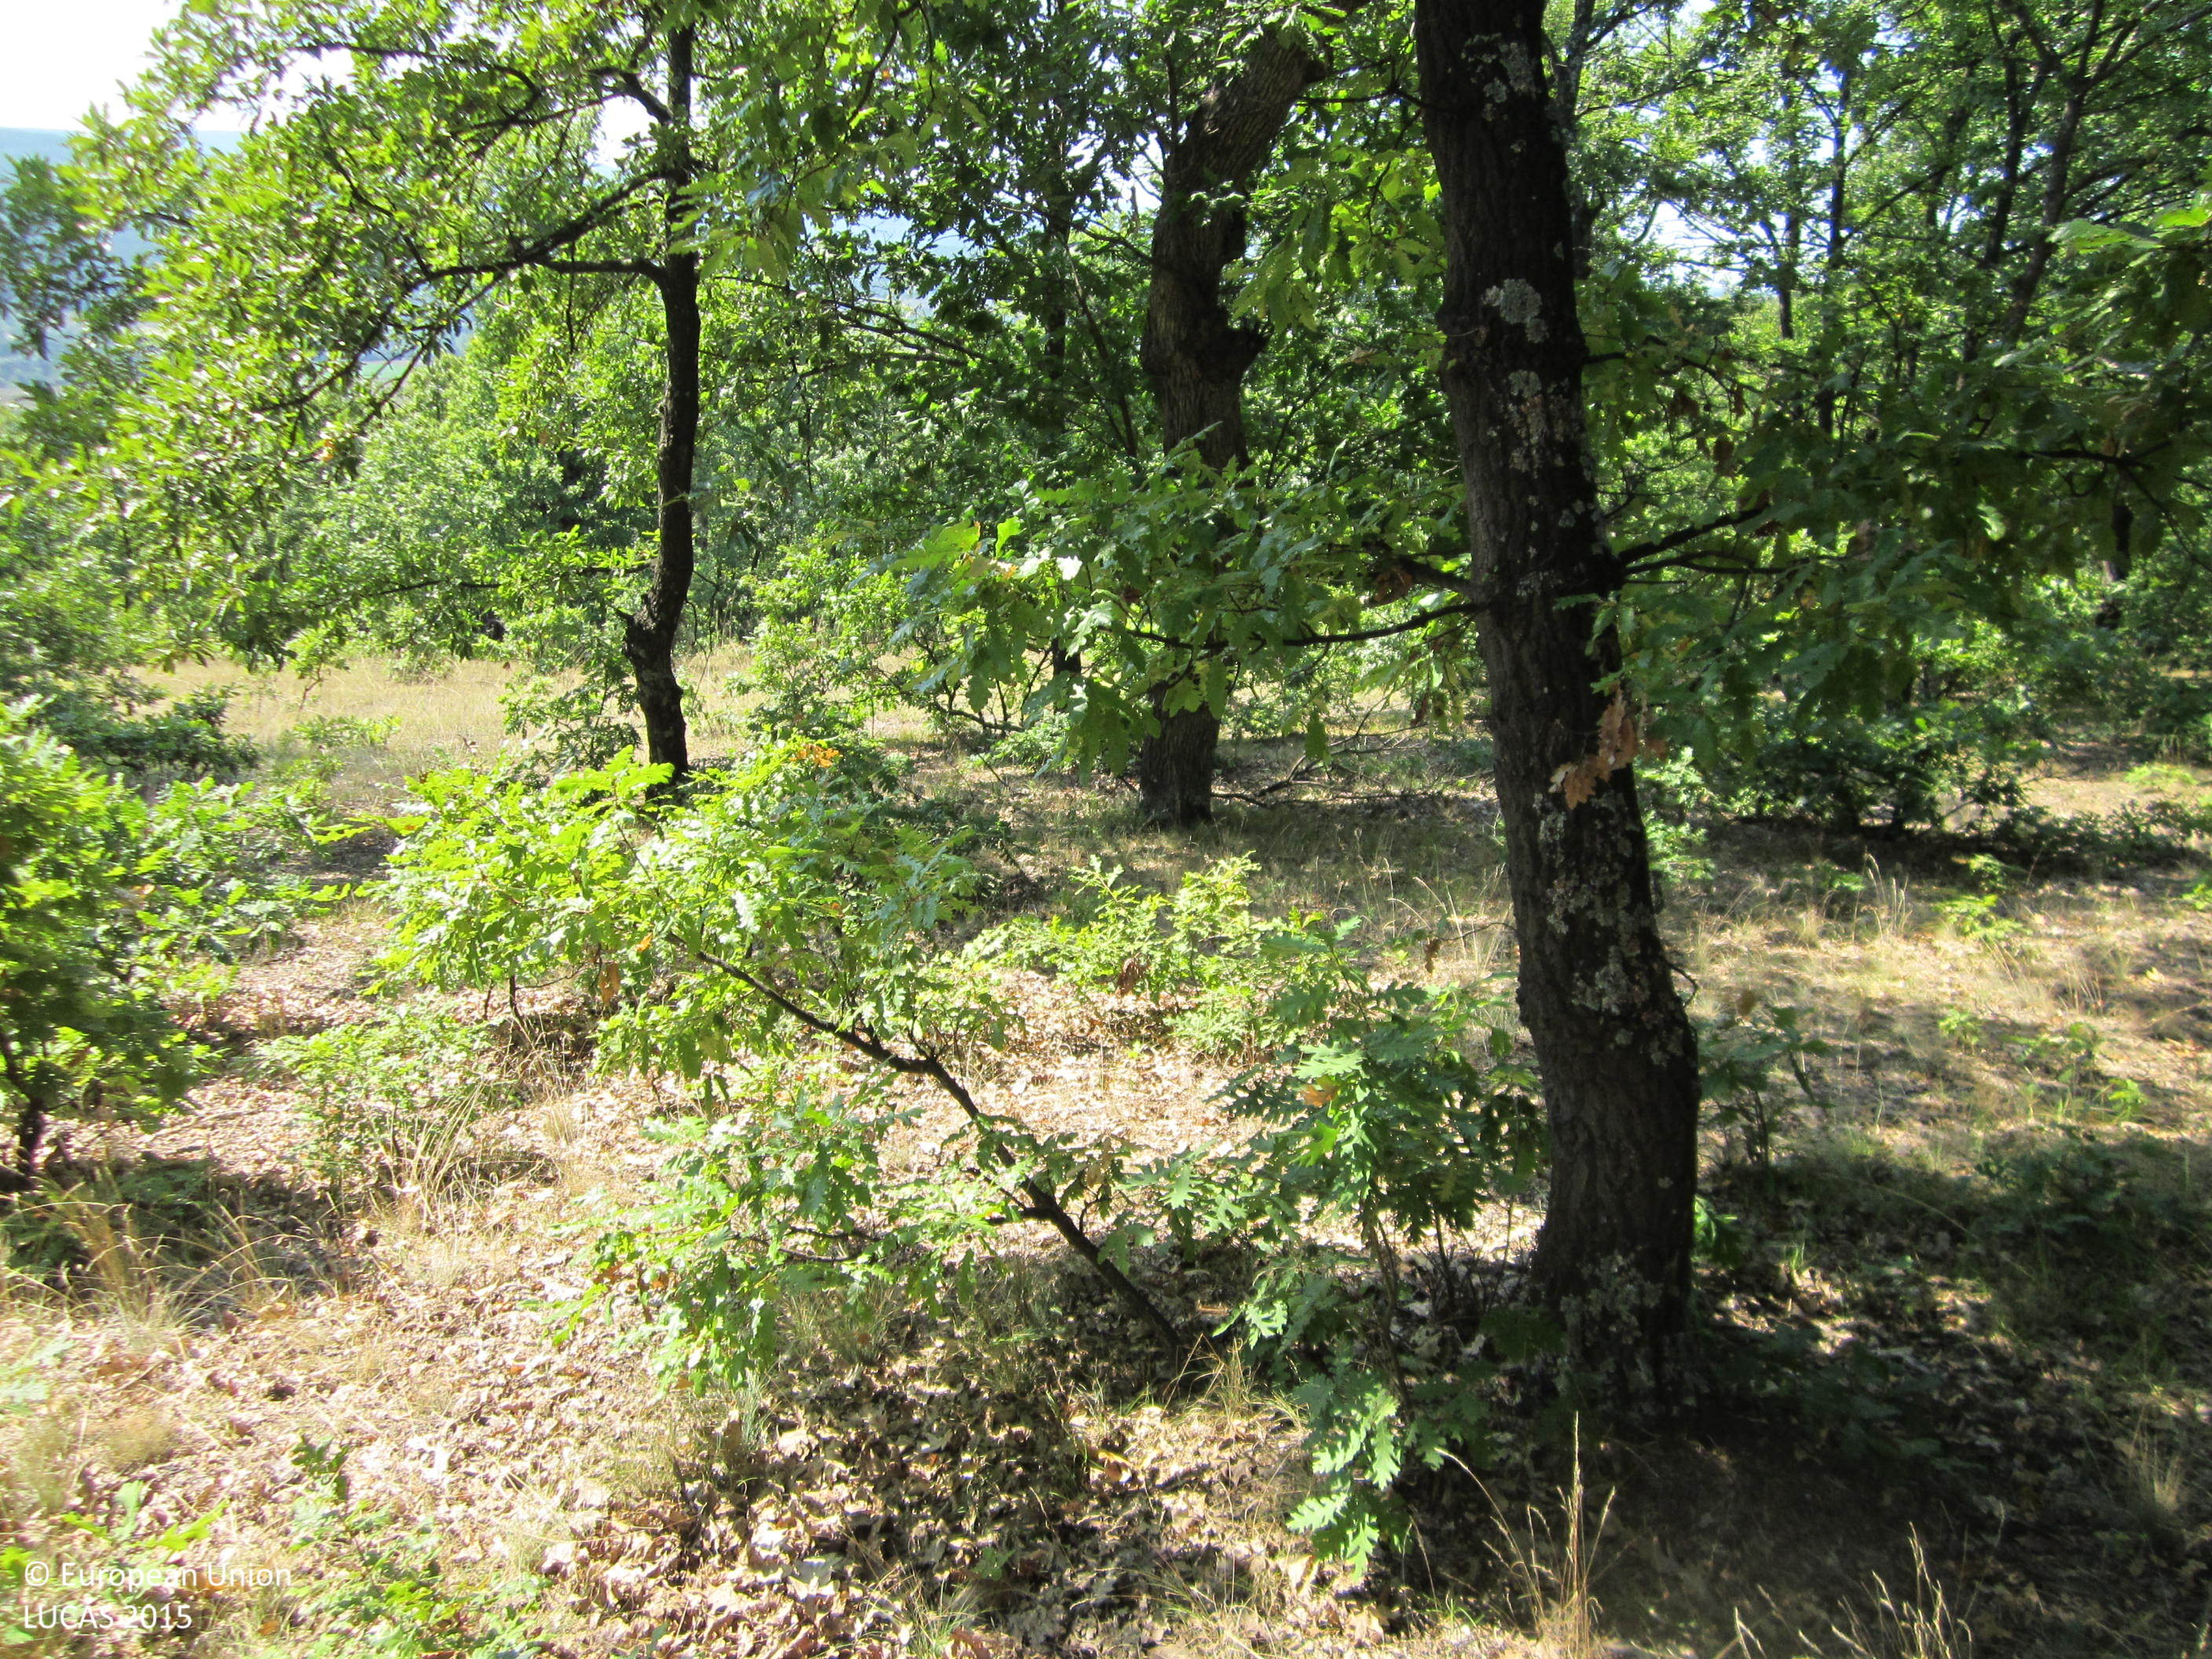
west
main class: Woodland
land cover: Broadleaved woodland
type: thermophilous deciduous forest
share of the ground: > 75 %
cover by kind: broadleaved forest trees 75 %, herbaceous plants 20 %, unconsolidated bare surface 5 %
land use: Forestry
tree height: > 5 m
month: September
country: BG
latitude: 42.8556
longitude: 27.0355
